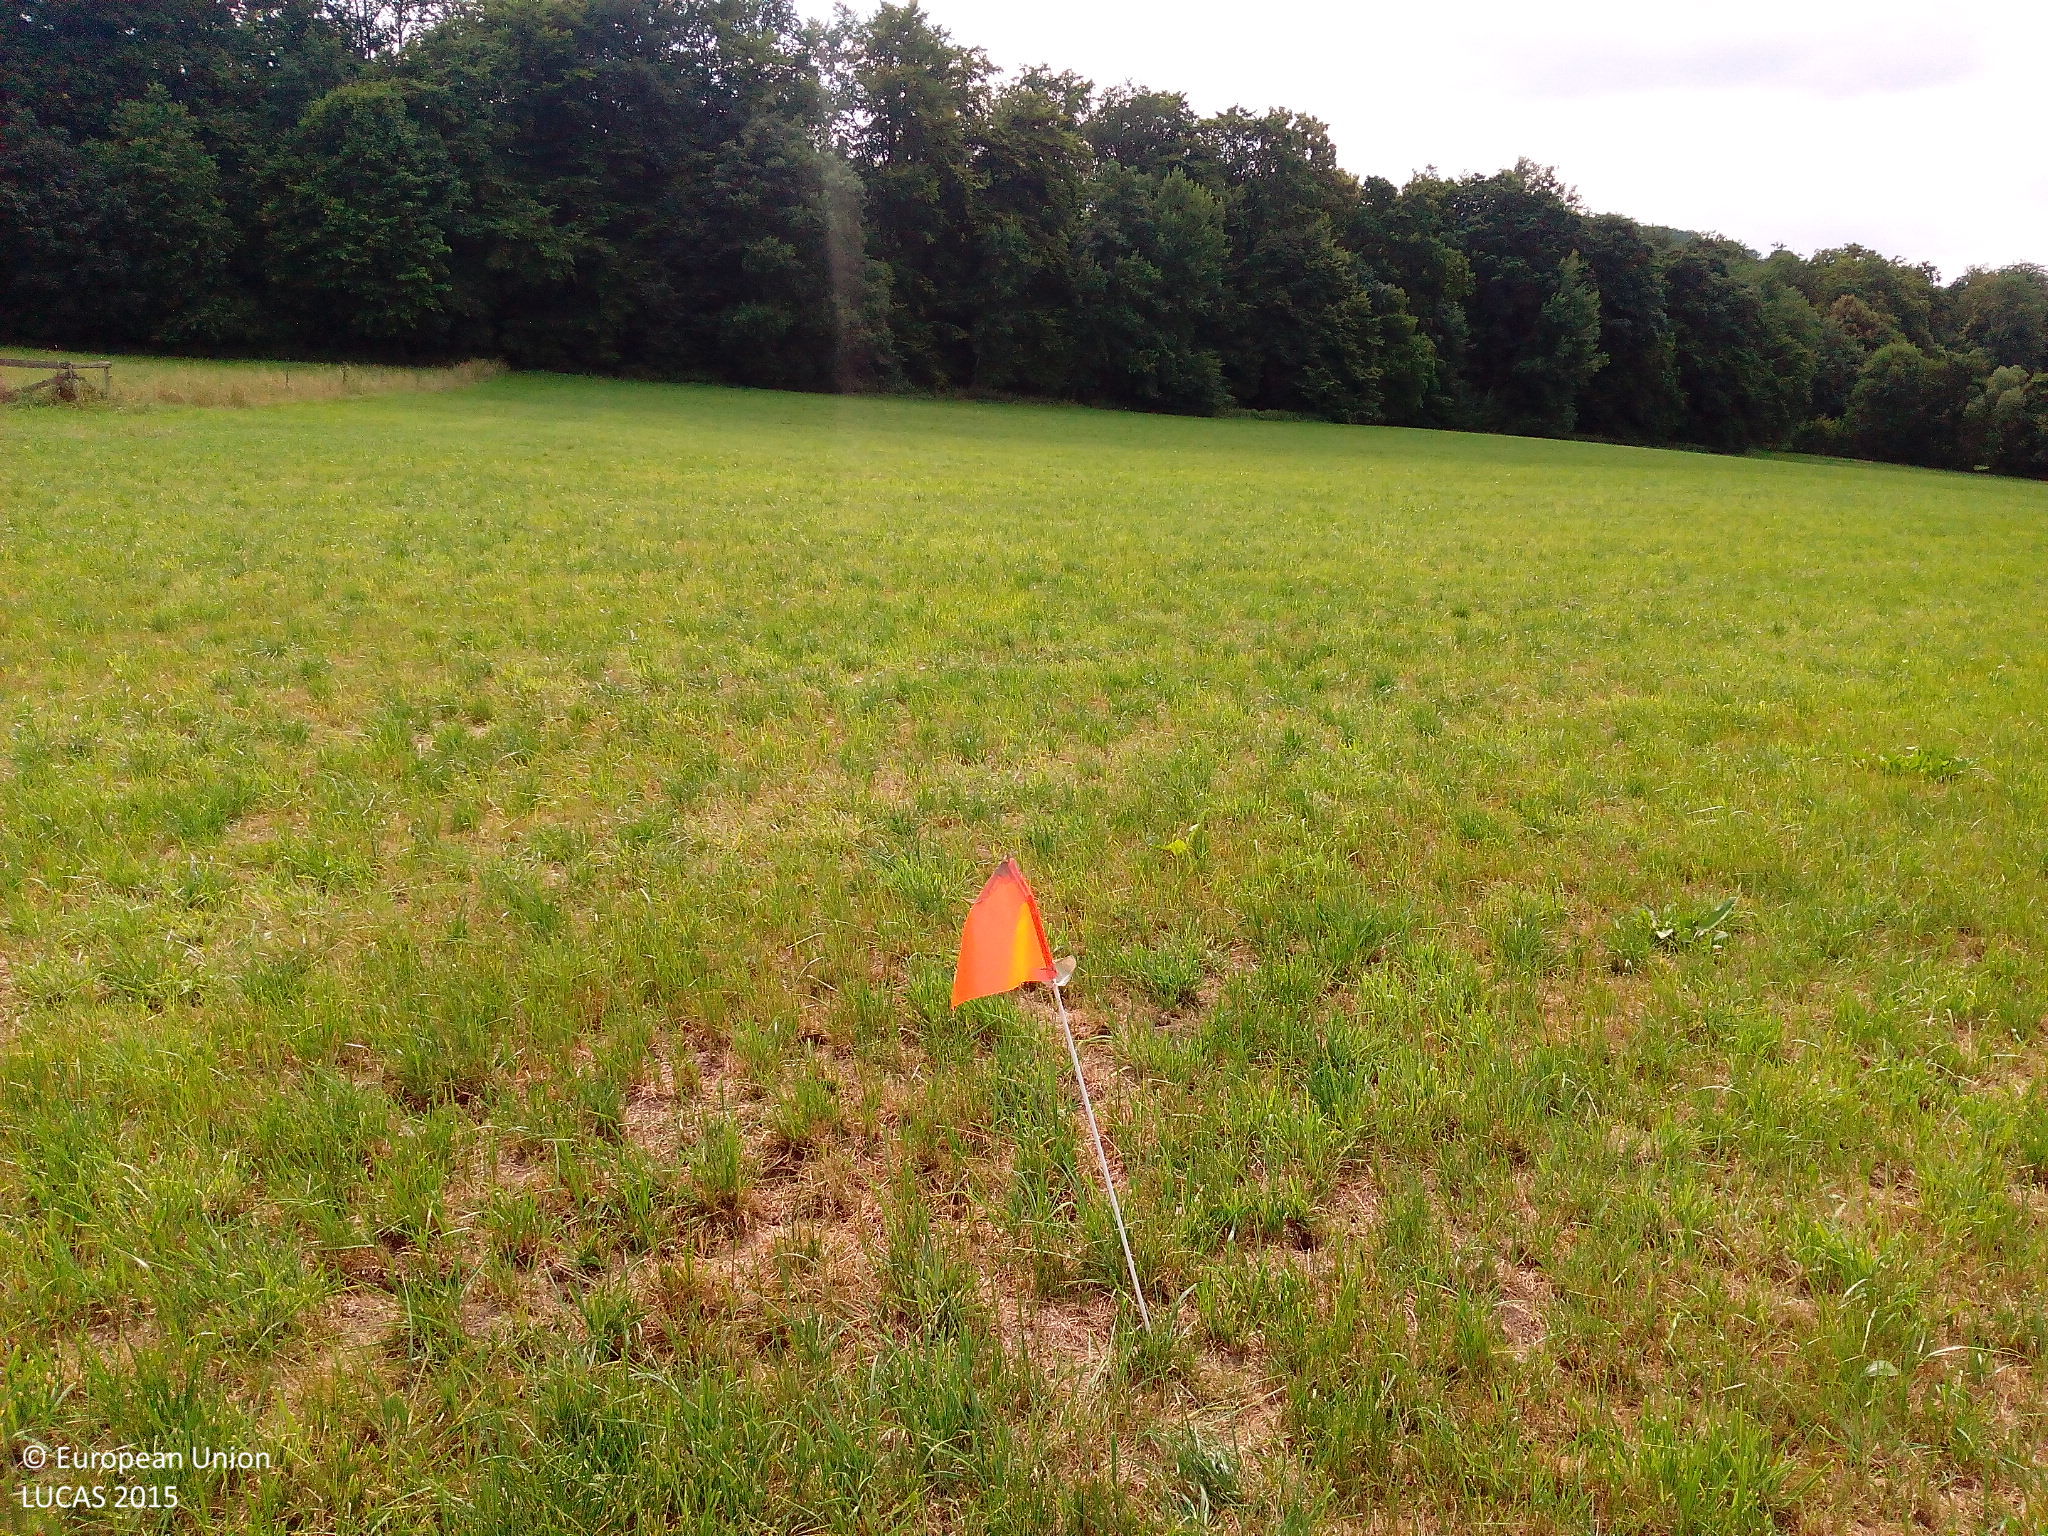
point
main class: Grassland
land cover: Grassland without tree/shrub cover
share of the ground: > 75 %
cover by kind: herbaceous plants 100 %
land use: Agriculture (excluding fallow land and kitchen gardens)
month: July
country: DE
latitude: 50.7056
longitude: 9.8726
